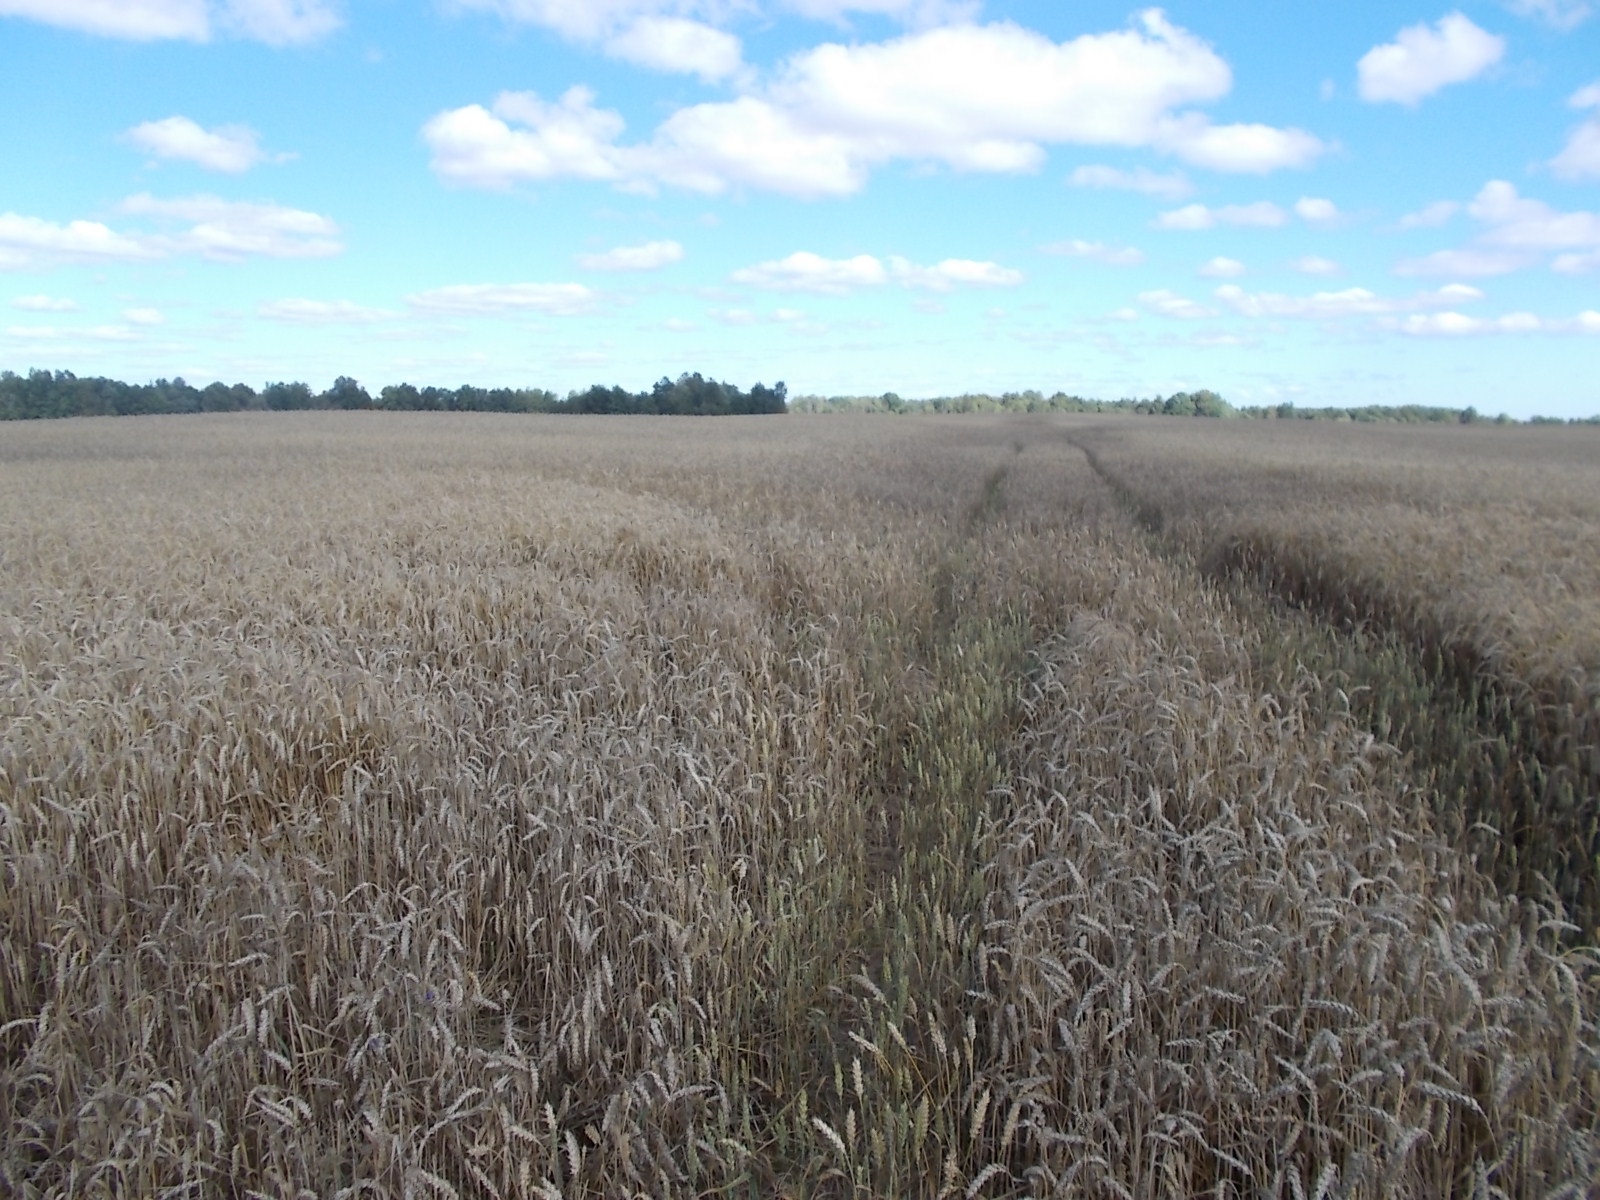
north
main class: Cropland
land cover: Common wheat
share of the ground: > 75 %
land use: Agriculture (excluding fallow land and kitchen gardens)
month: August
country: LV
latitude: 56.9168
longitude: 22.9242
